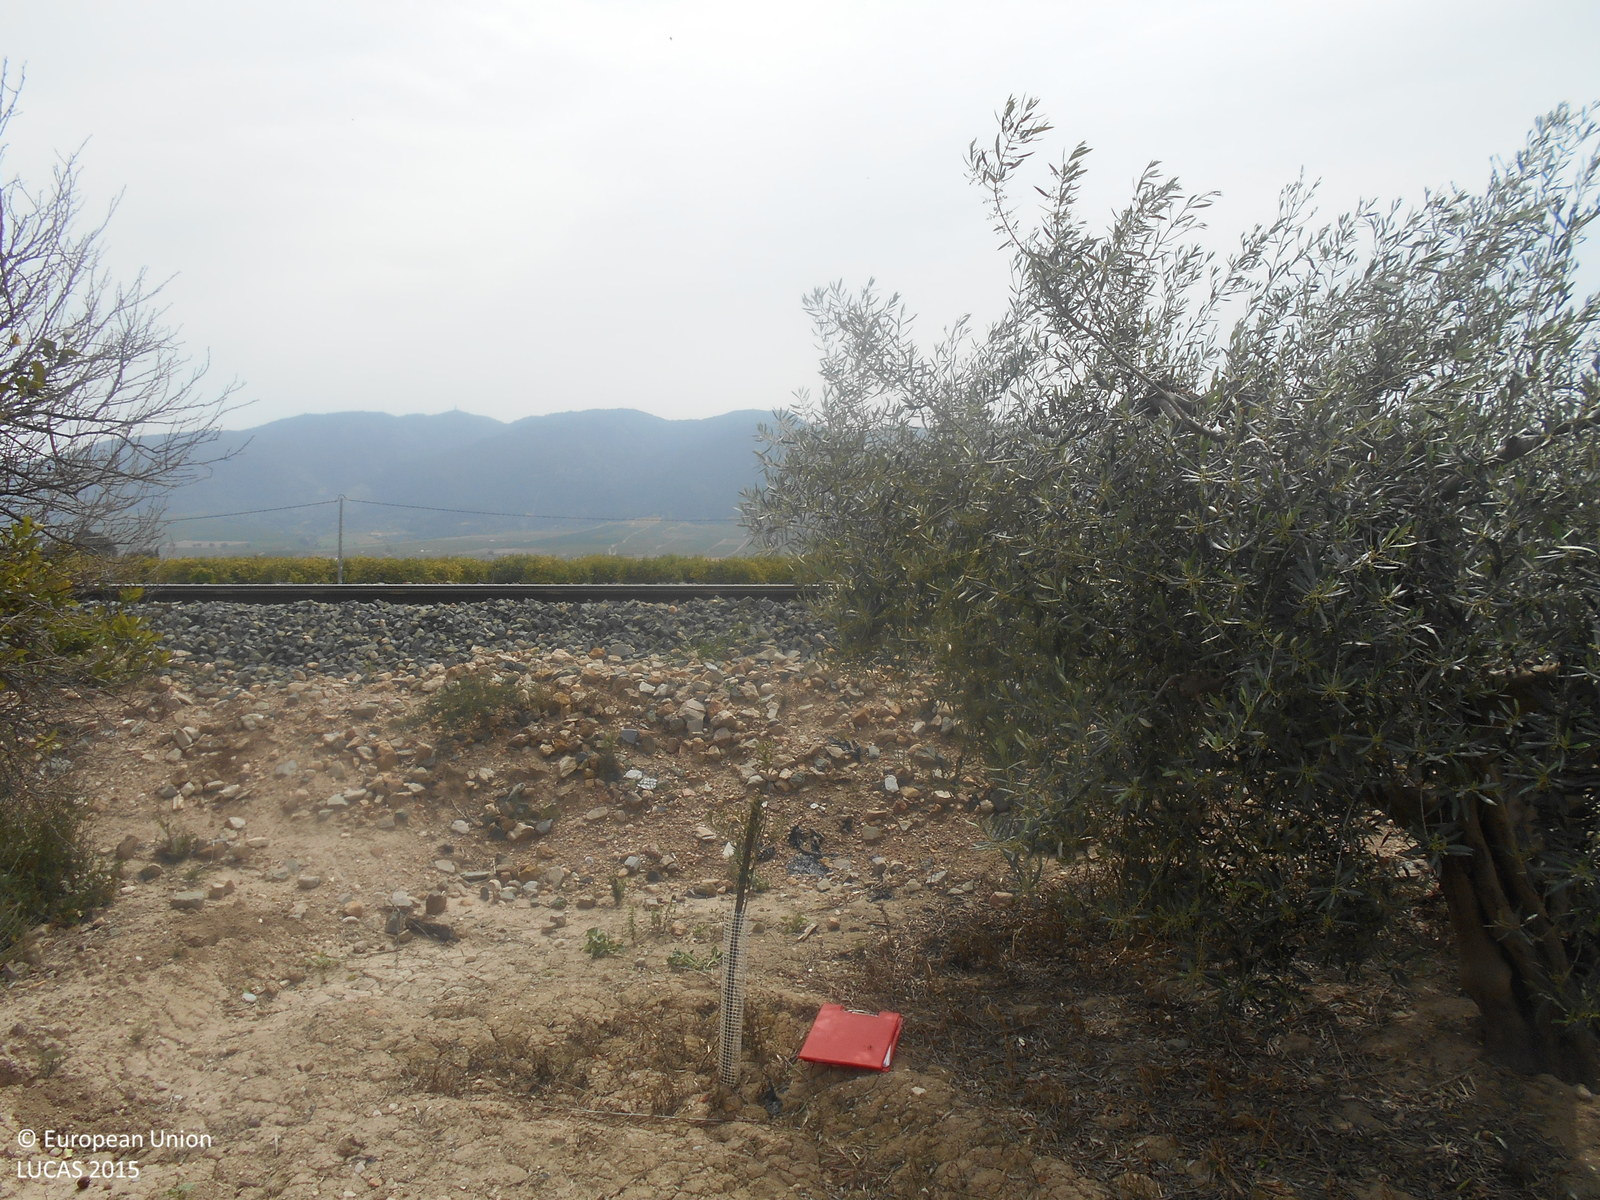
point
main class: Cropland
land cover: Olive groves
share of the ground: 10 - 25 %
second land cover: Other bare soil
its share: > 75 %
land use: Agriculture (excluding fallow land and kitchen gardens)
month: April
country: ES
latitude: 37.8897
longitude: -1.3432
